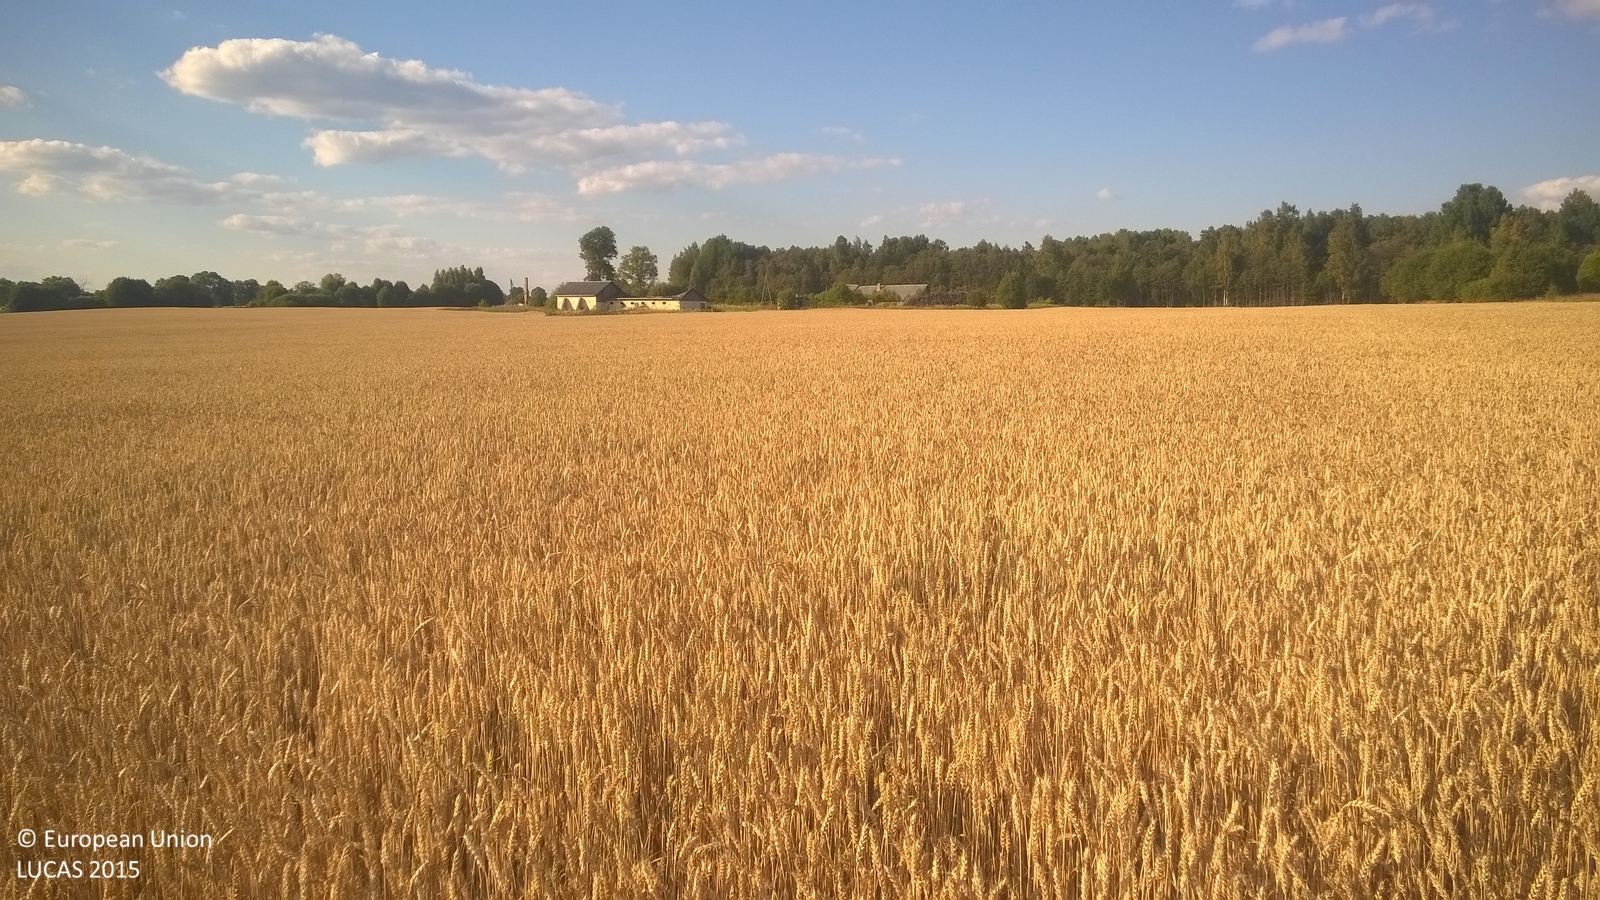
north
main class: Cropland
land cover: Common wheat
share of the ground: > 75 %
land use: Agriculture (excluding fallow land and kitchen gardens)
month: August
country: LV
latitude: 57.8745
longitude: 25.7142
